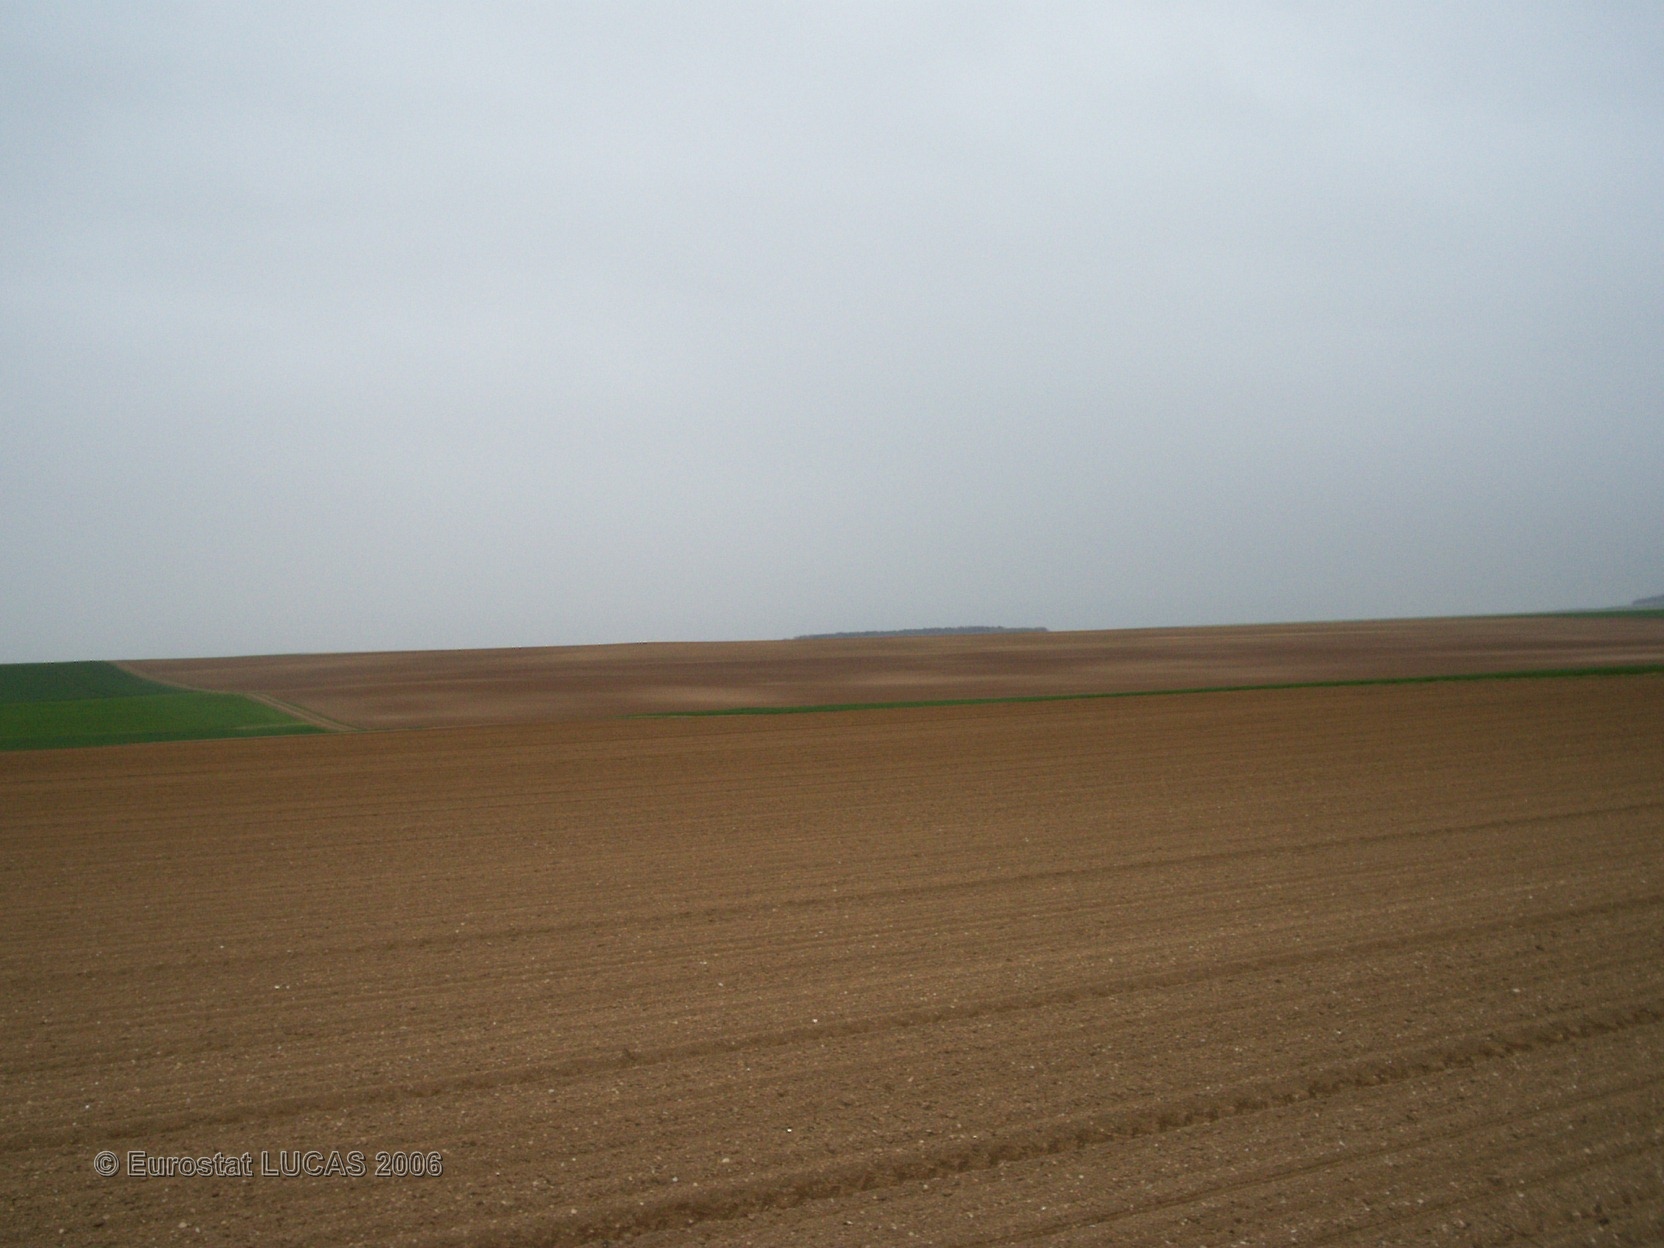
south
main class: Cropland
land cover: Dry pulses
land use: Agriculture (excluding fallow land and kitchen gardens)
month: April
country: FR
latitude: 49.2523
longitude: 4.3770
